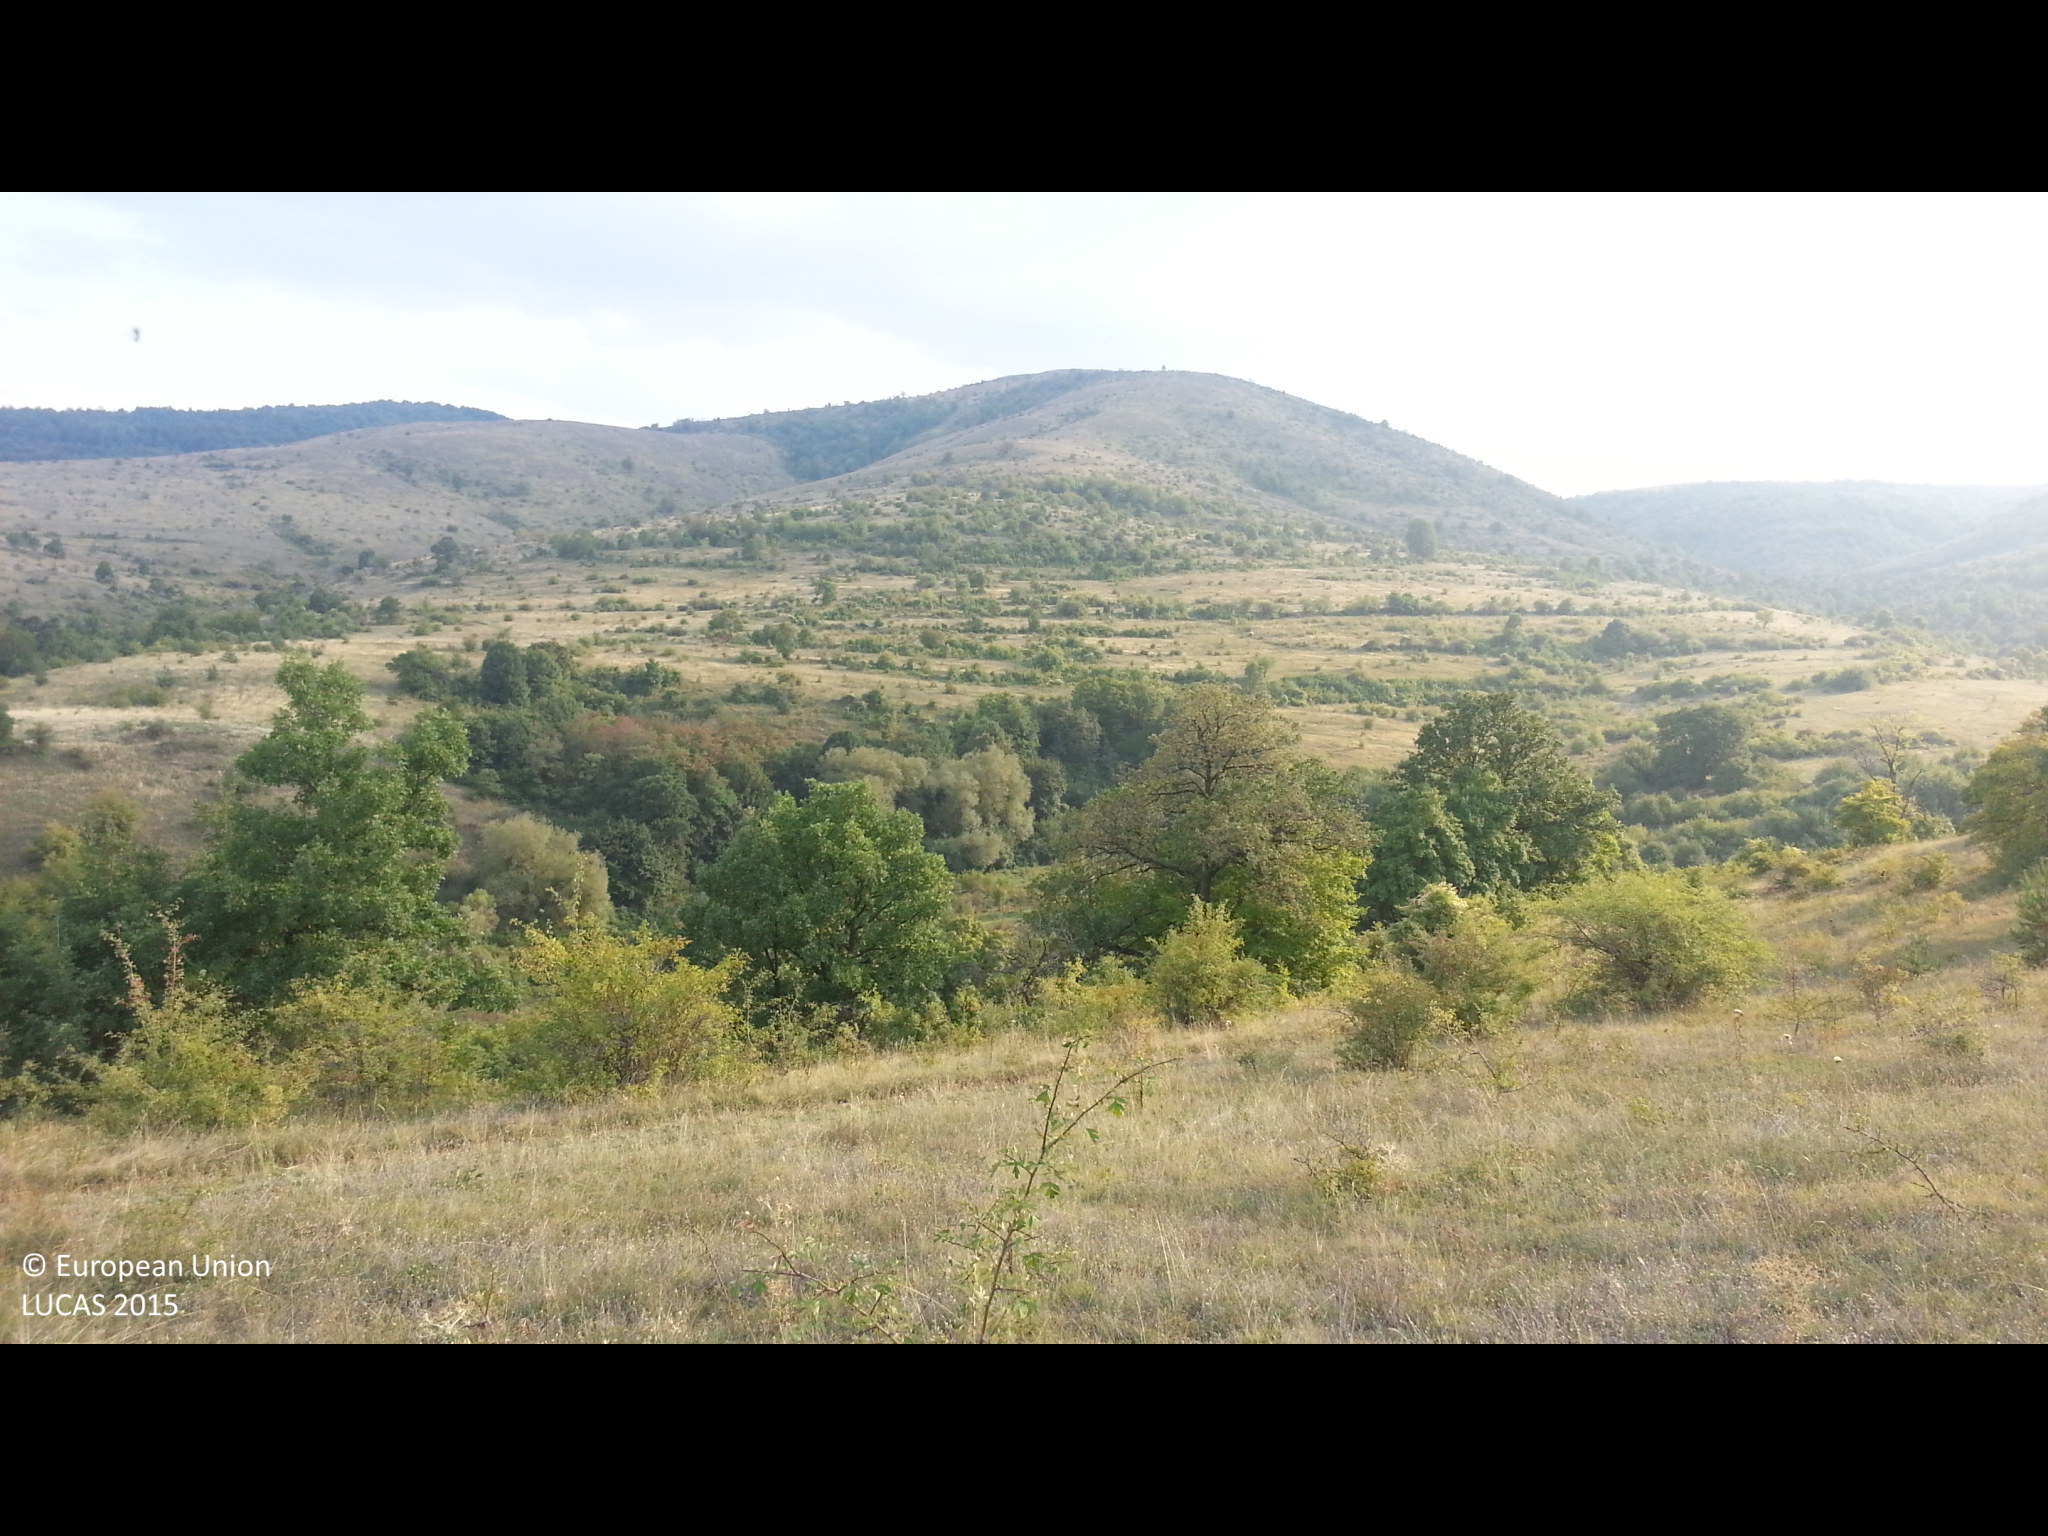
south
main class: Grassland
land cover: Grassland with sparse tree/shrub cover
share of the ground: > 75 %
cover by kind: herbaceous plants 90 %, broadleaved forest trees 5 %, shrubs 5 %
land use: Agriculture (excluding fallow land and kitchen gardens)
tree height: < 5 m
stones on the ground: < 10 %
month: September
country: BG
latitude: 42.5487
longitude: 23.0966
